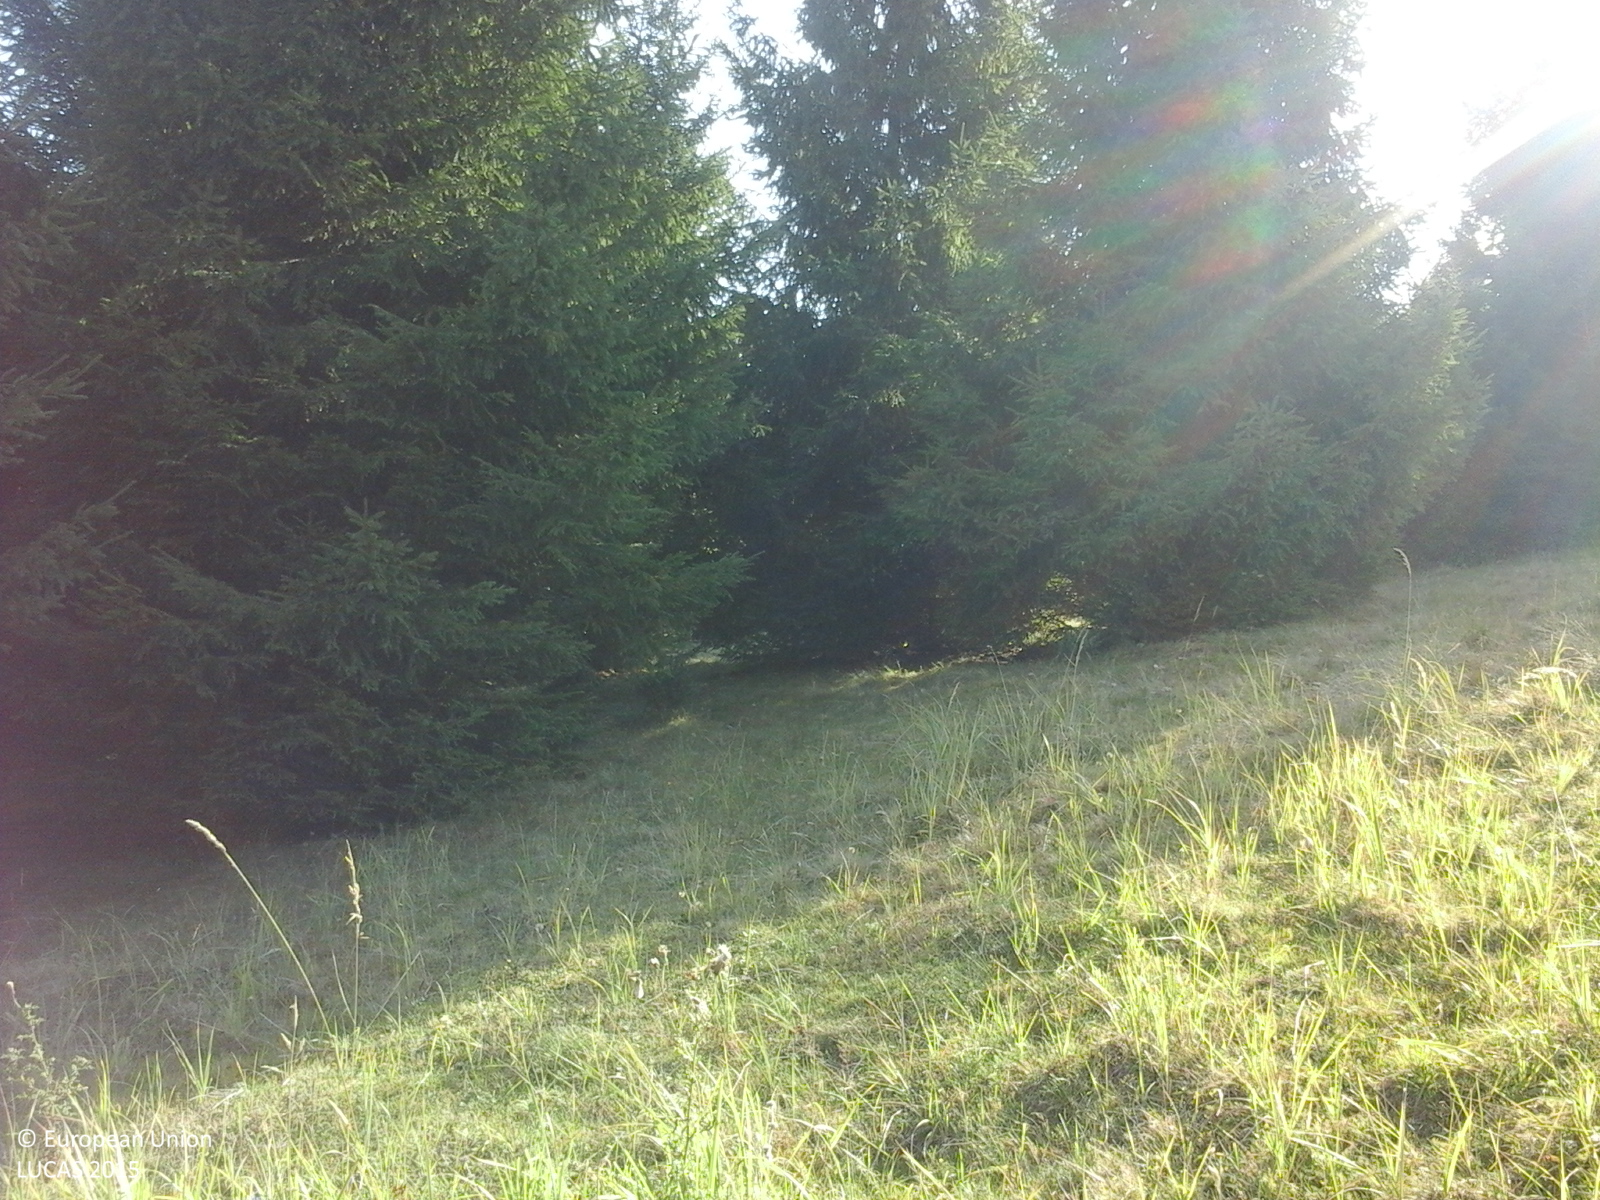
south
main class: Grassland
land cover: Grassland without tree/shrub cover
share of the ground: > 75 %
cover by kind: herbaceous plants 100 %
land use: Forestry
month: October
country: RO
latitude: 46.2195
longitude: 25.9994
